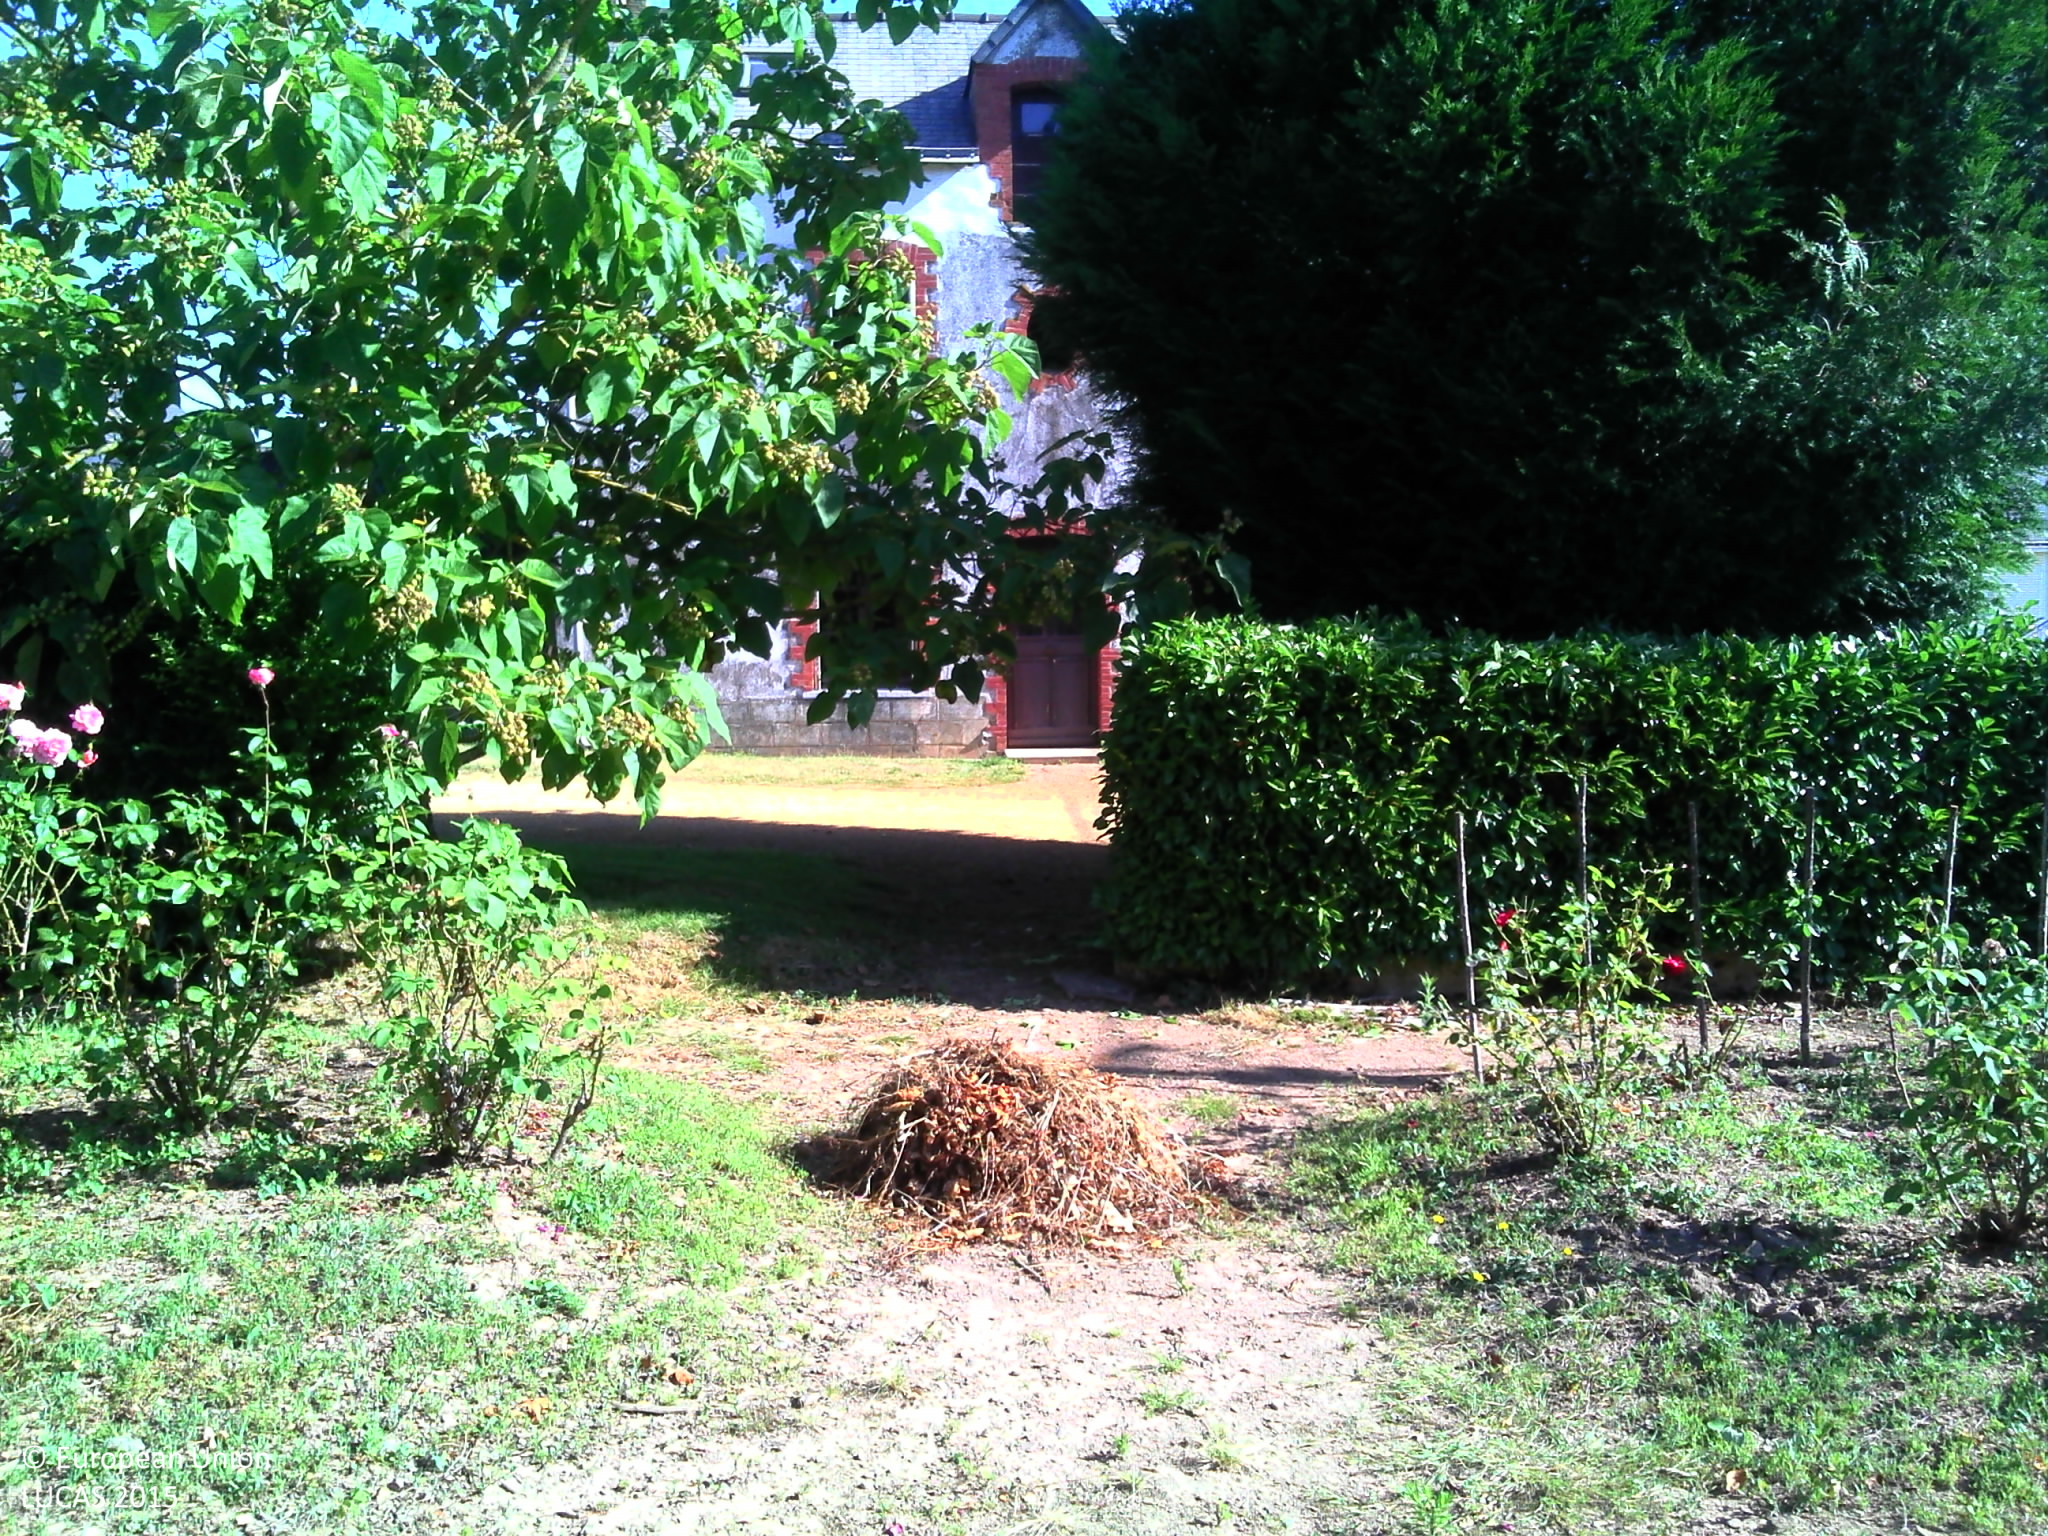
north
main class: Cropland
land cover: Floriculture and ornamental plants
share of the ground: < 10 %
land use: Kitchen garden
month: July
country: FR
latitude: 47.6570
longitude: -1.9937
